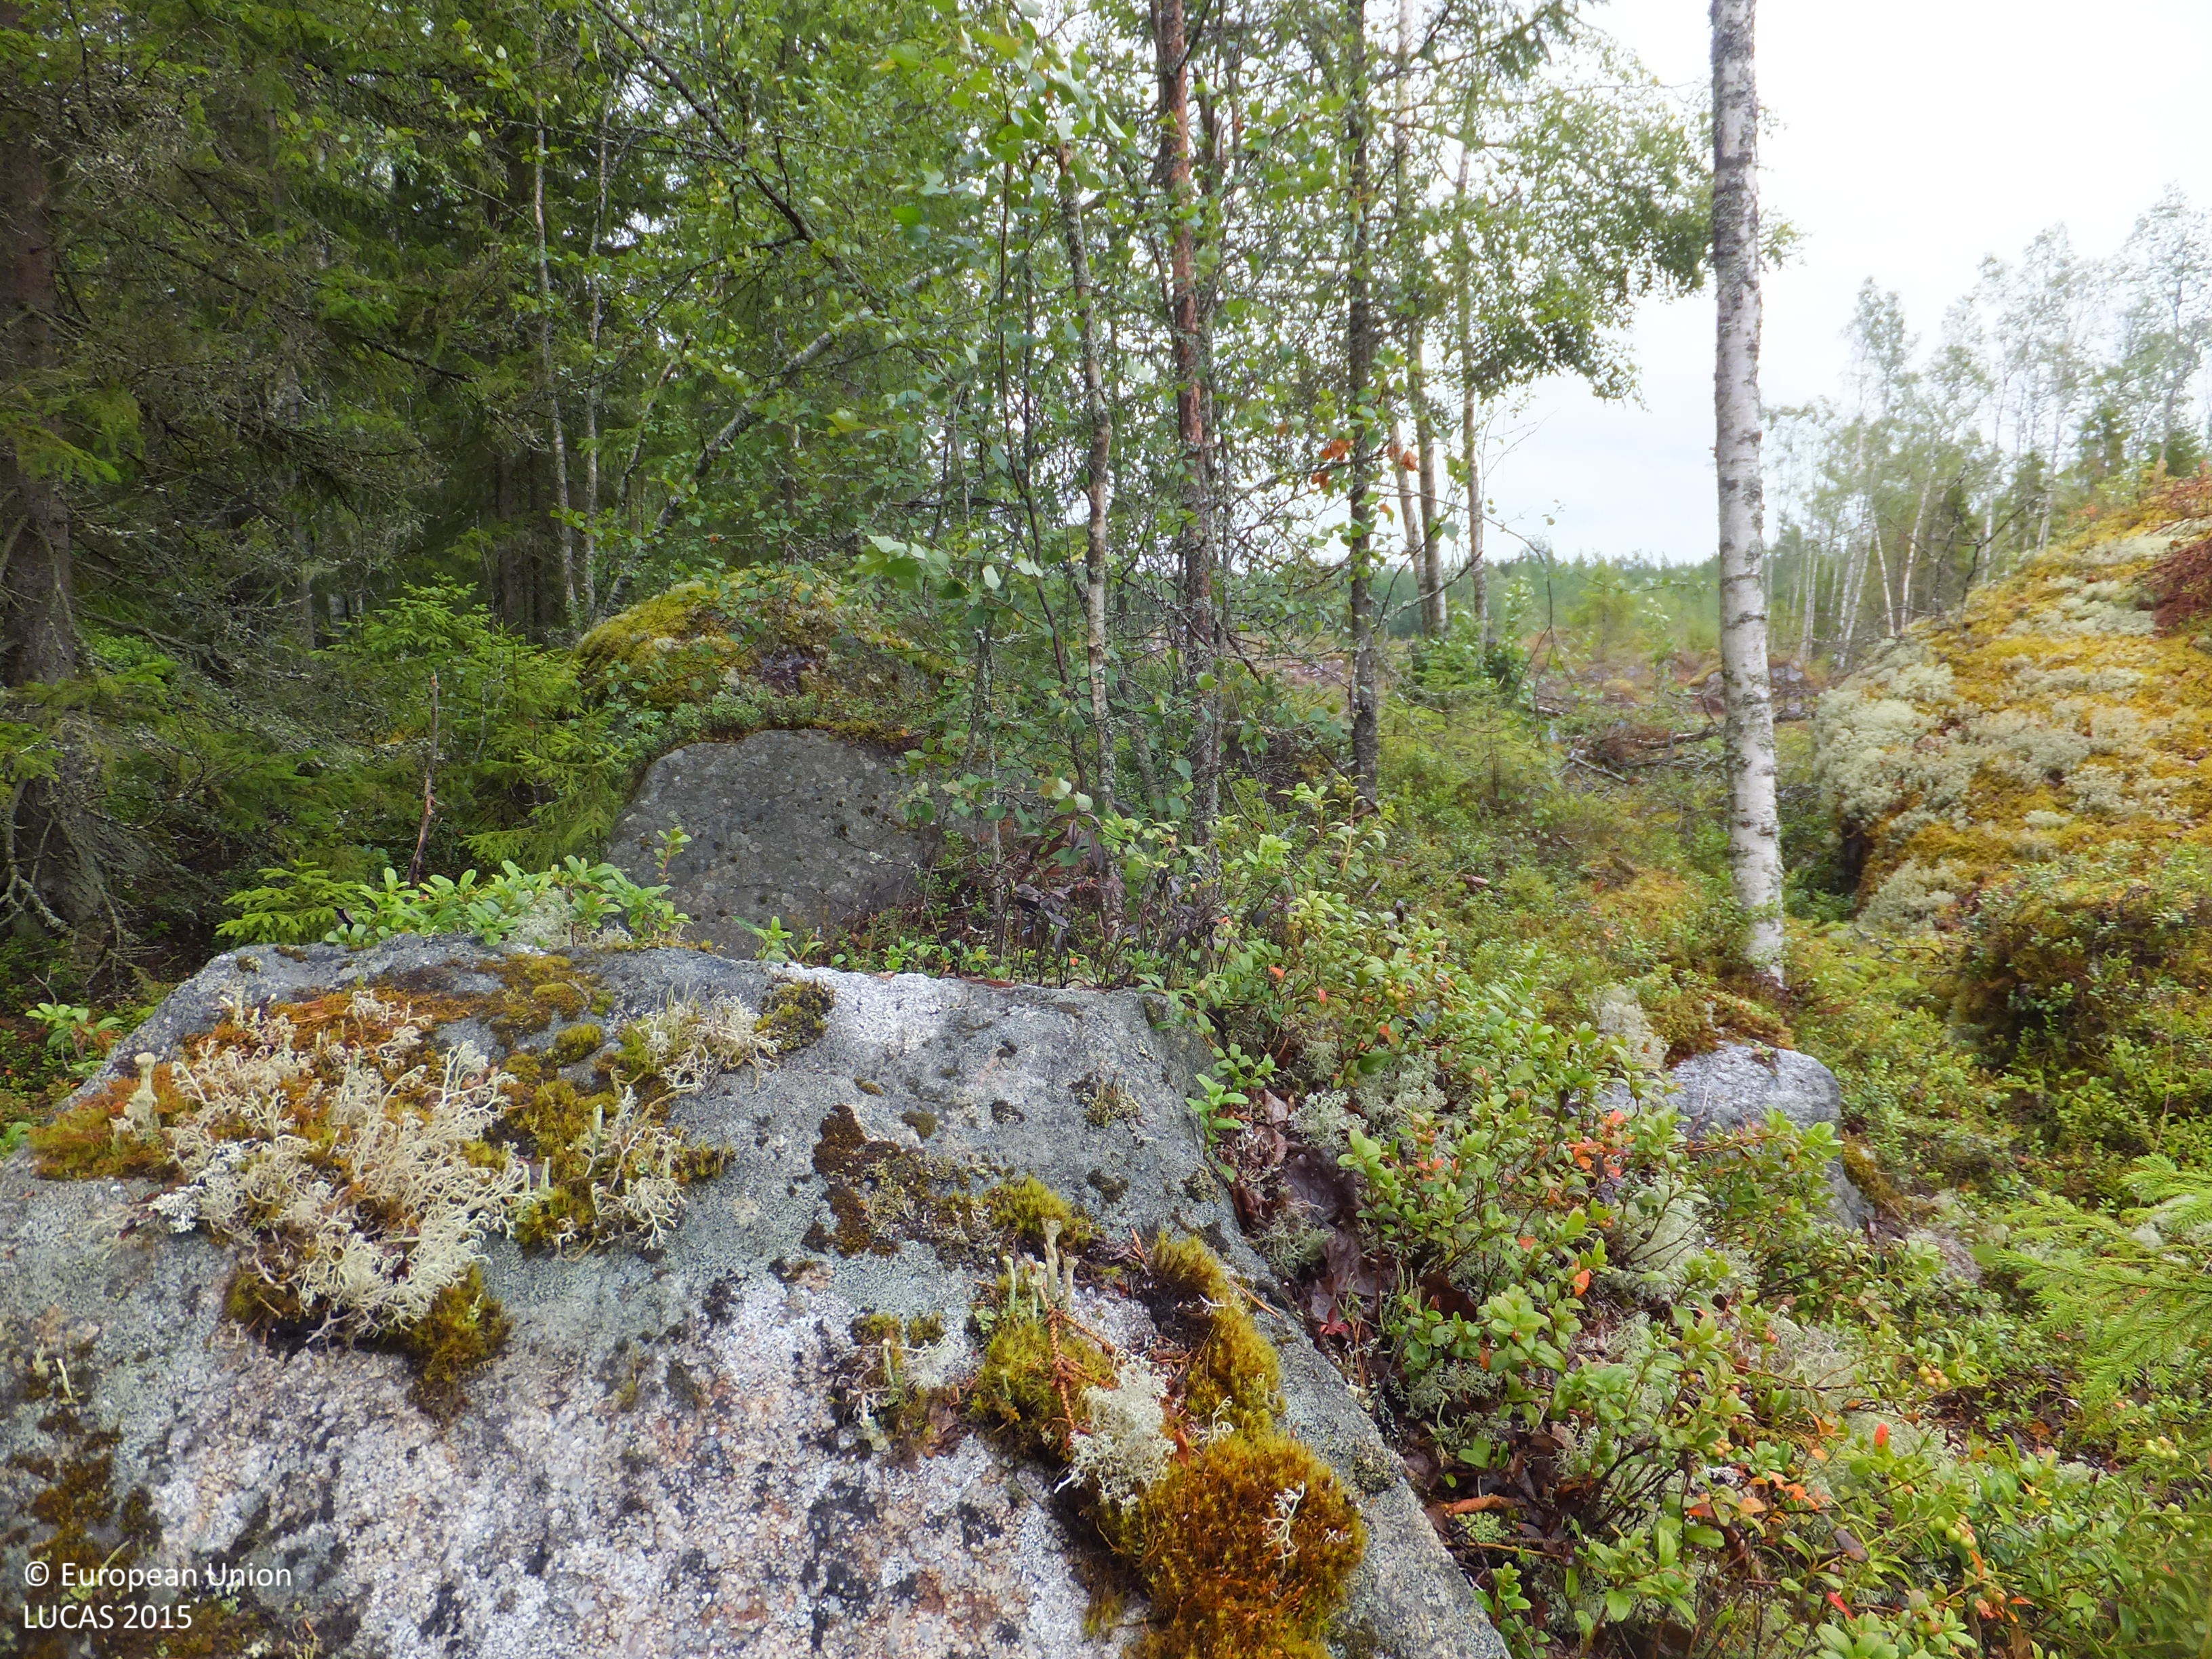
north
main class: Woodland
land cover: Other mixed woodland
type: boreal forest
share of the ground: 50 - 75 %
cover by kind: coniferous forest trees 30 %, broadleaved forest trees 30 %, shrubs 20 %, lichens and mosses 10 %, consolidated bare surface 10 %
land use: Forestry
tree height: > 5 m
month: July
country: FI
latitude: 63.2426
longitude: 21.8072
